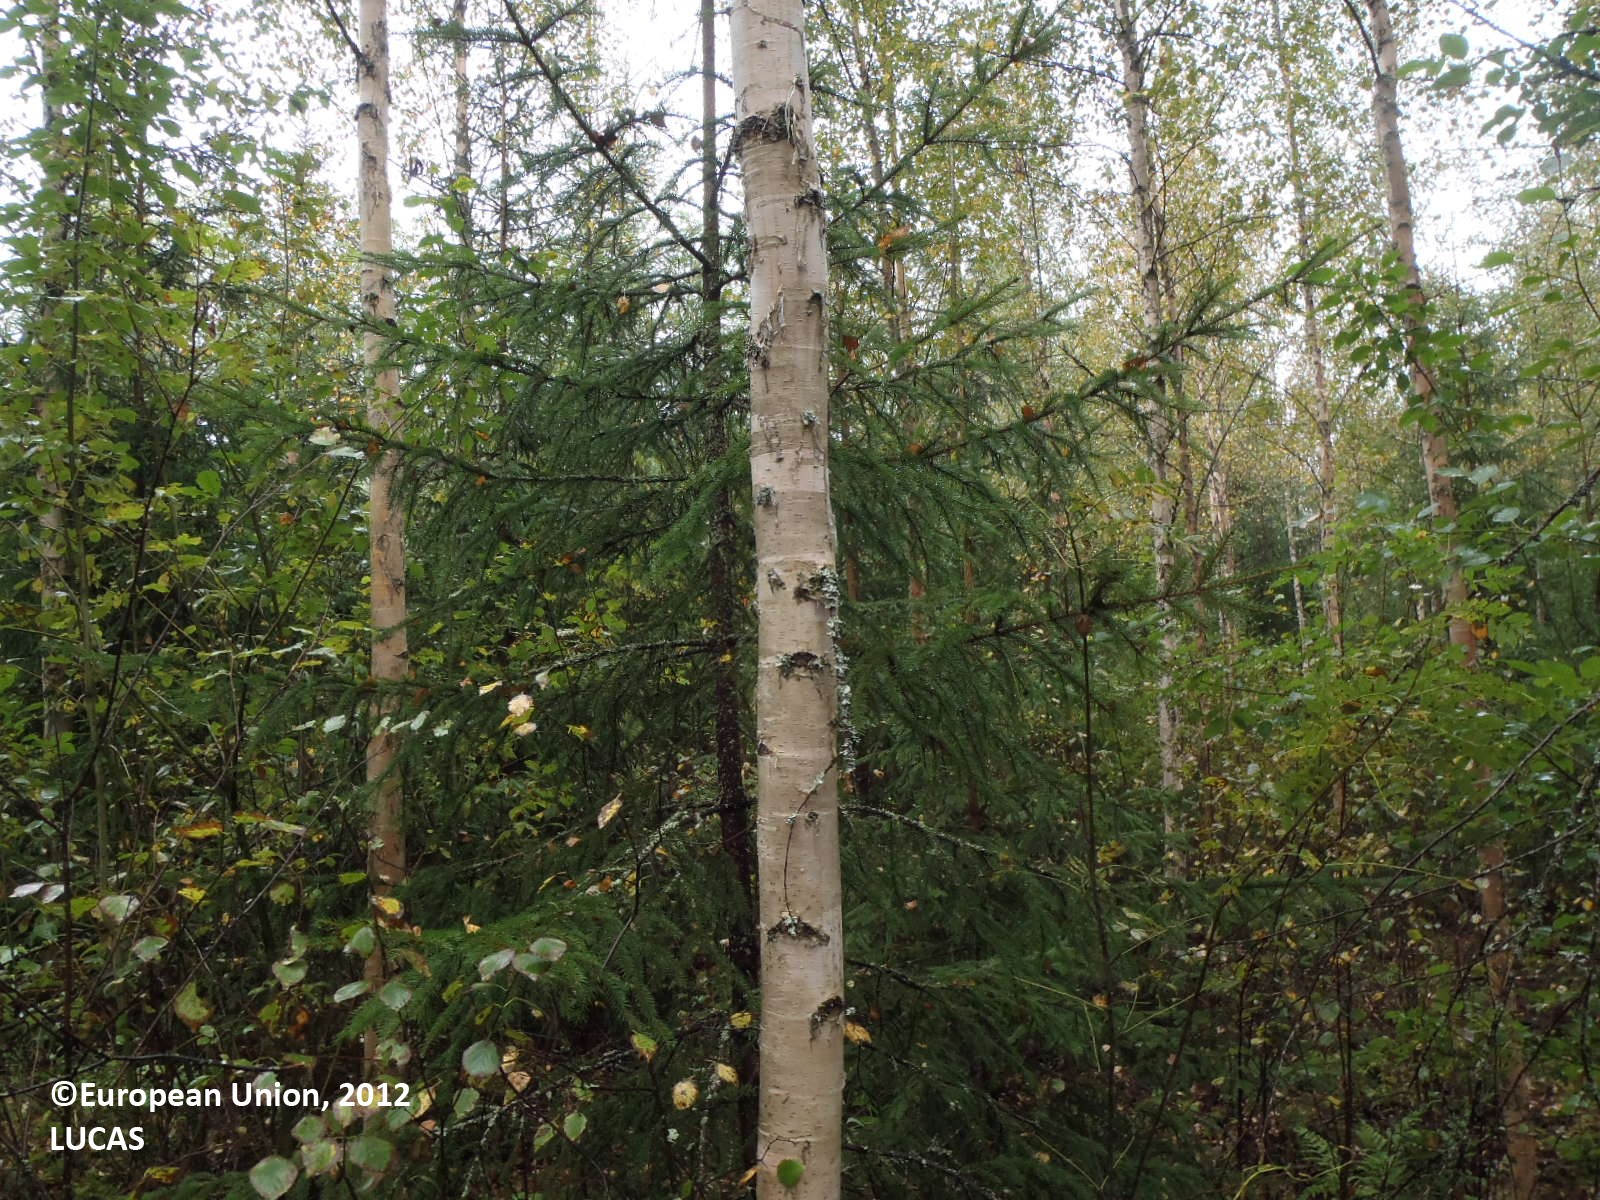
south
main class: Woodland
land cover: Broadleaved woodland
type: boreal forest
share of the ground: > 75 %
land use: Forestry
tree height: > 5 m
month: September
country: FI
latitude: 61.6049
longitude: 22.5995
